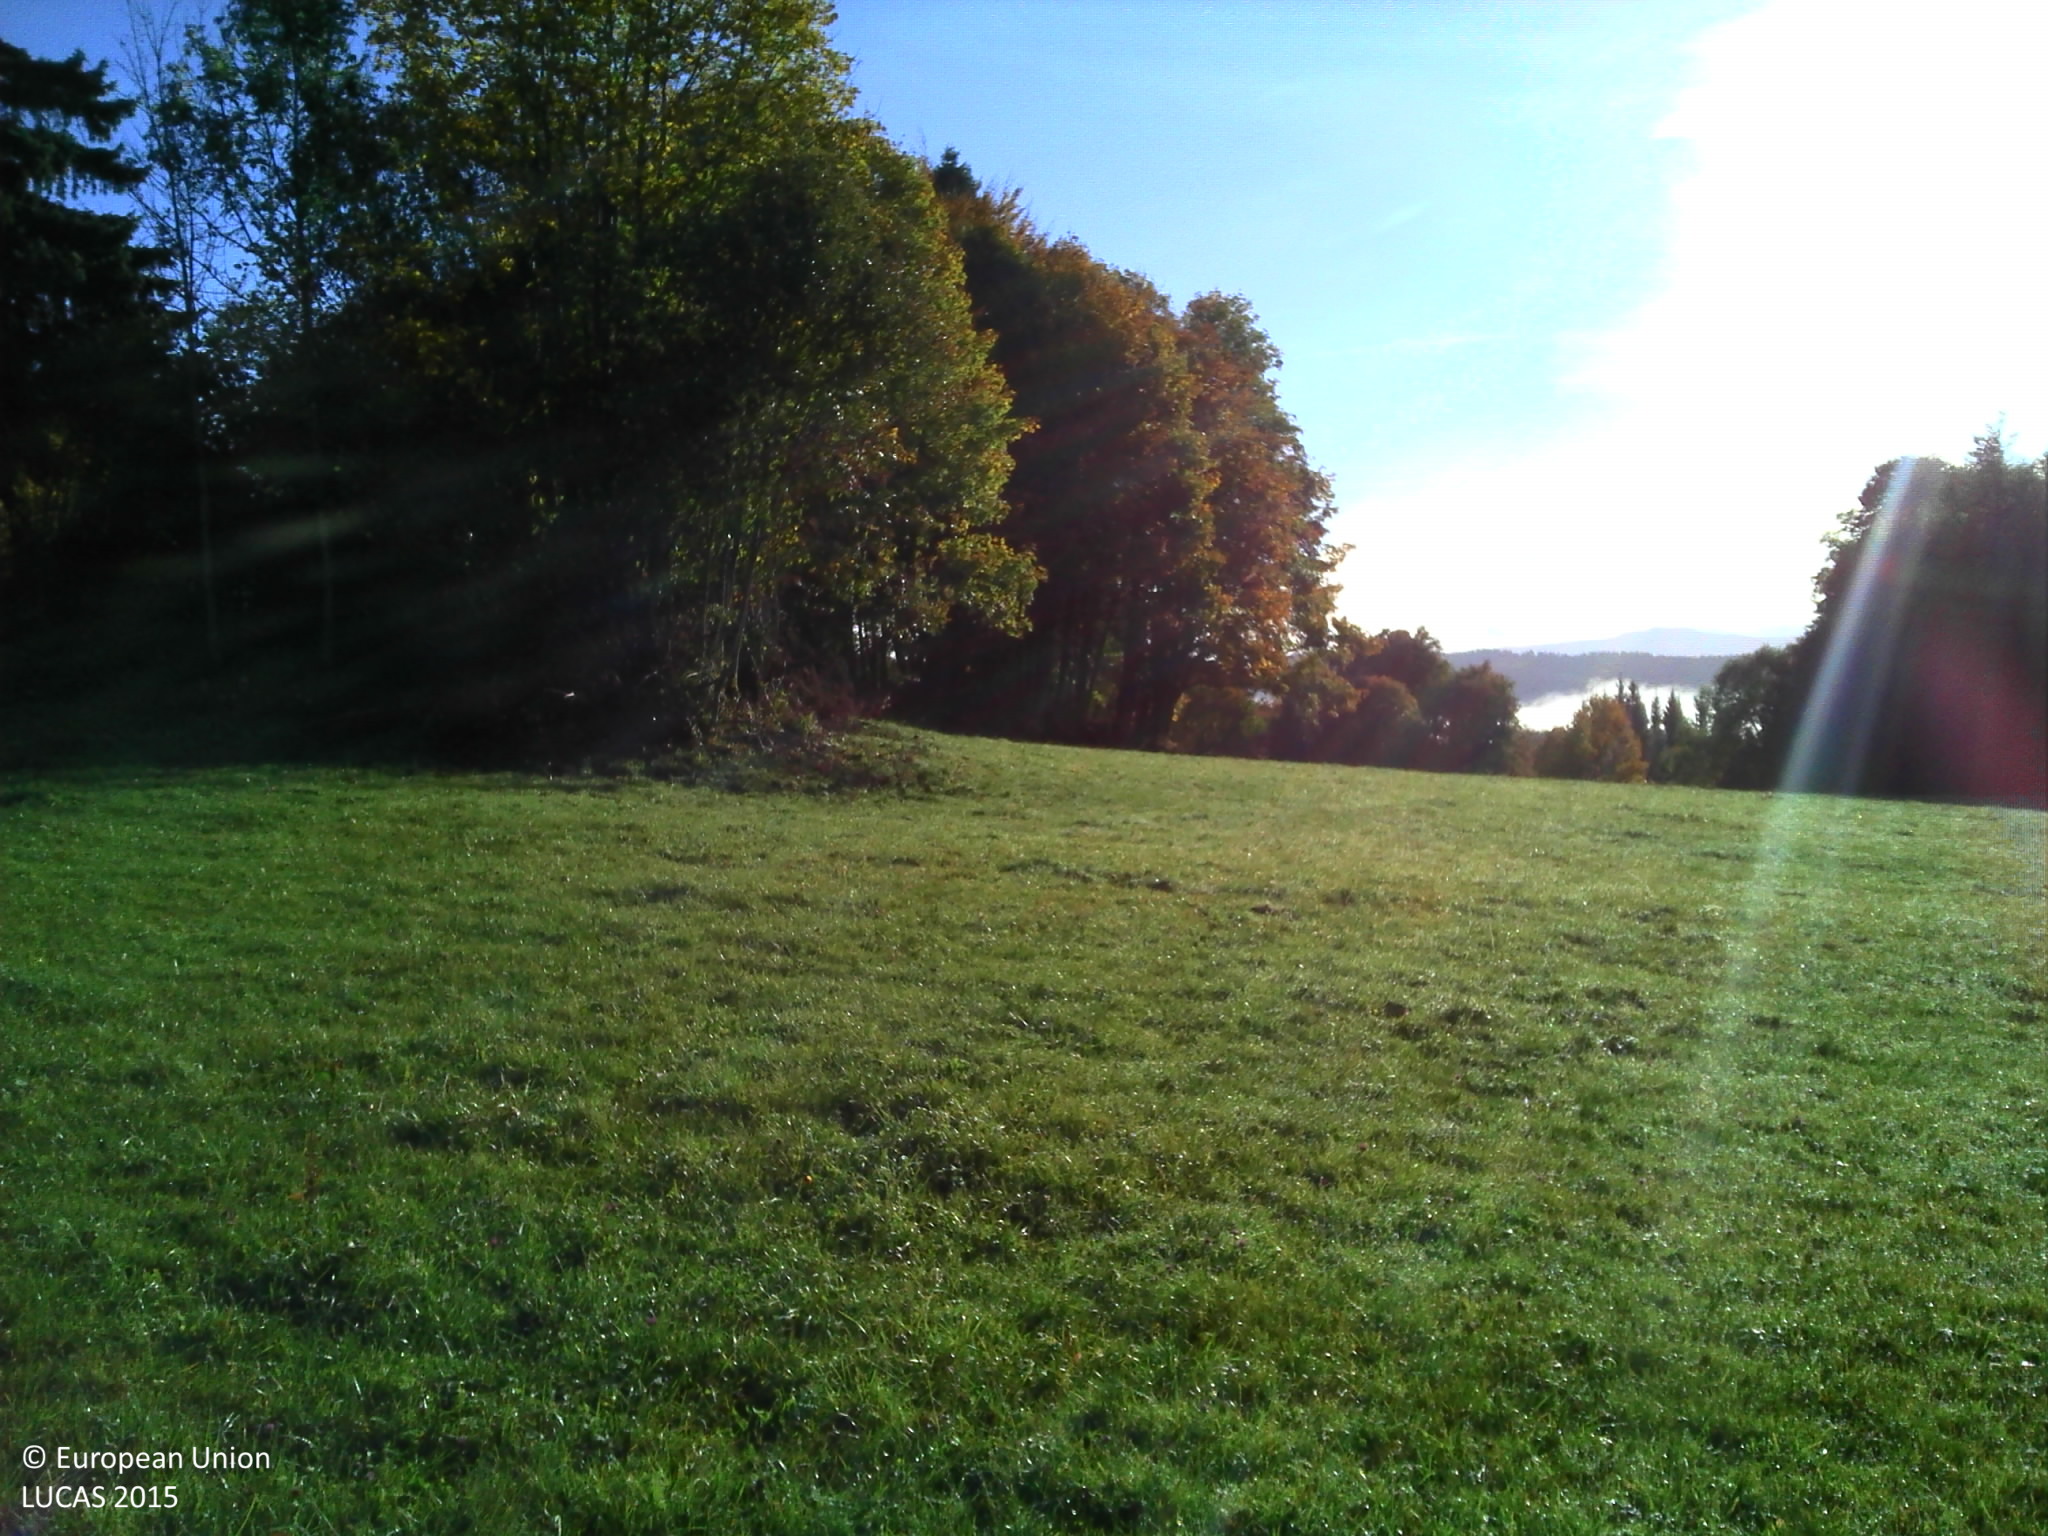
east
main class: Grassland
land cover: Grassland without tree/shrub cover
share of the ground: > 75 %
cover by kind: herbaceous plants 100 %
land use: Agriculture (excluding fallow land and kitchen gardens)
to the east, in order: Grassland without tree/shrub cover; Broadleaved woodland; Grassland without tree/shrub cover; Single bushes/trees; Grassland without tree/shrub cover; Fences; Grassland without tree/shrub cover
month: October
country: FR
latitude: 46.8853
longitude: 6.3936
